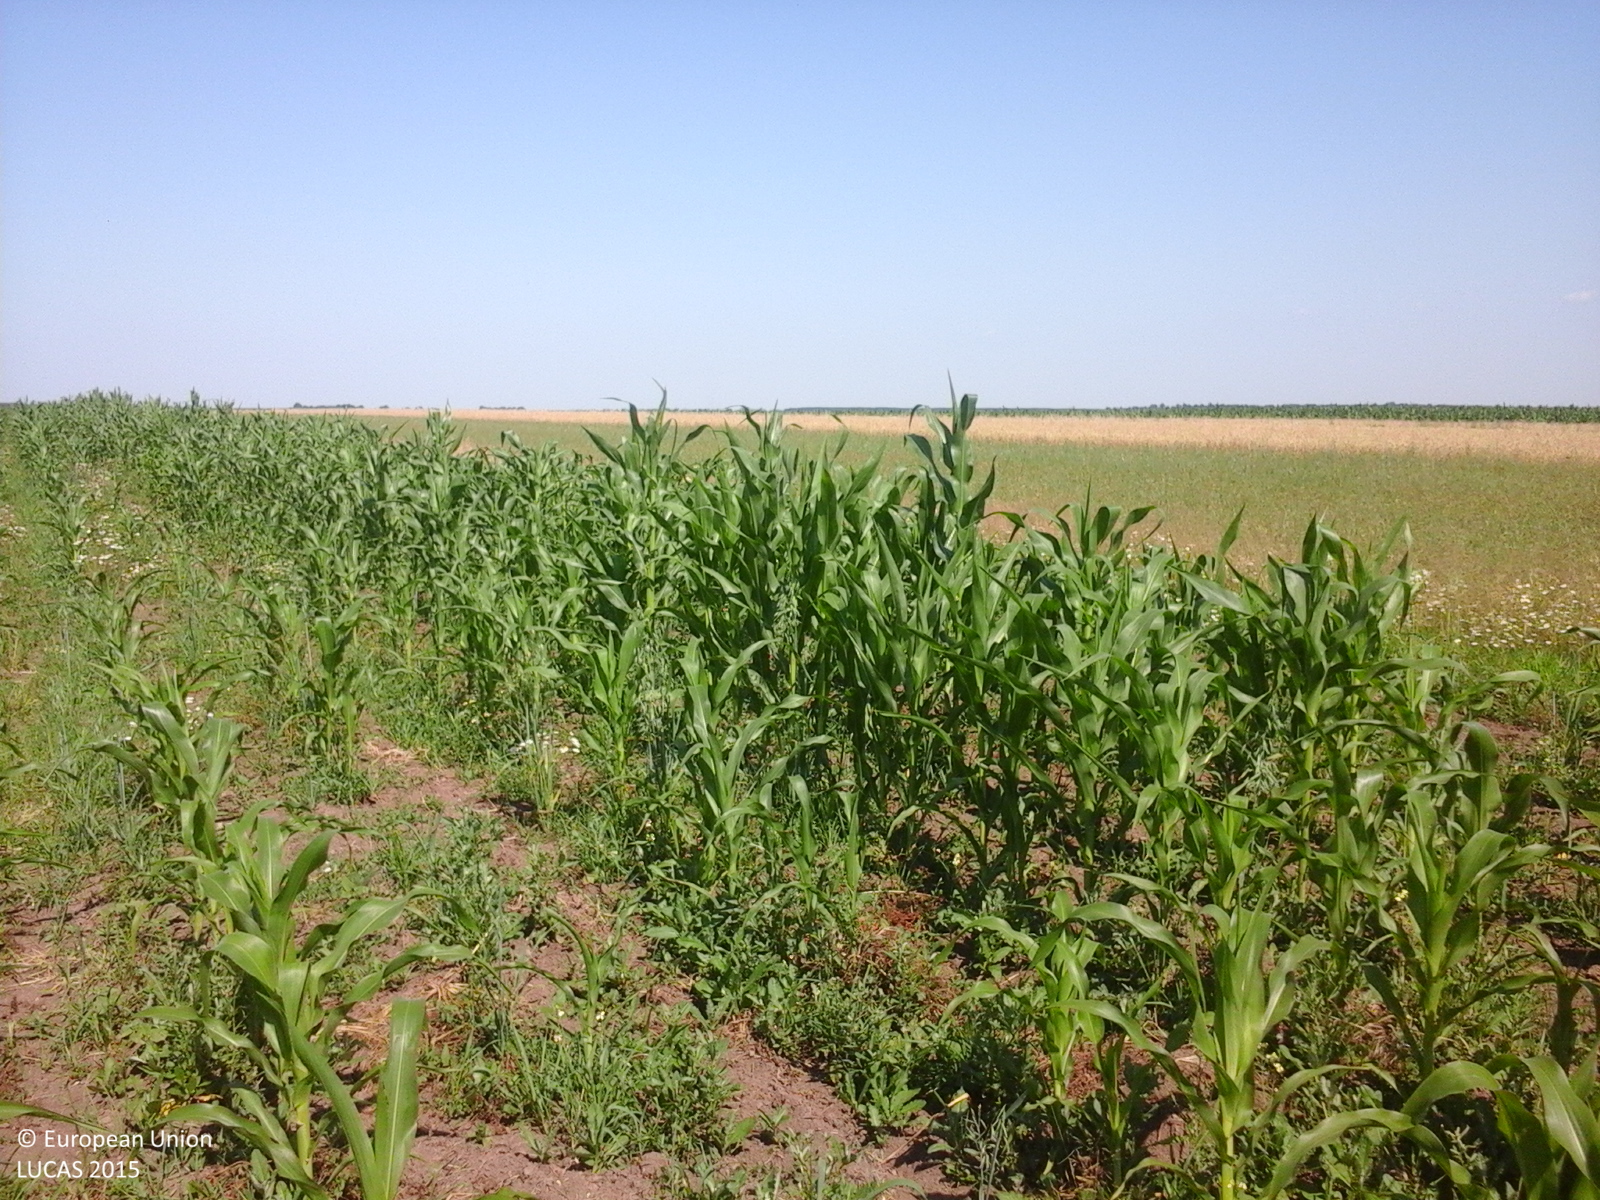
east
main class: Cropland
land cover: Maize
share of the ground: 50 - 75 %
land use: Agriculture (excluding fallow land and kitchen gardens)
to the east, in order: Maize; Spontaneously vegetated surfaces; Common wheat; Other bare soil; Grassland without tree/shrub cover; Maize
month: July
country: RO
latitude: 44.5153
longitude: 24.6291
